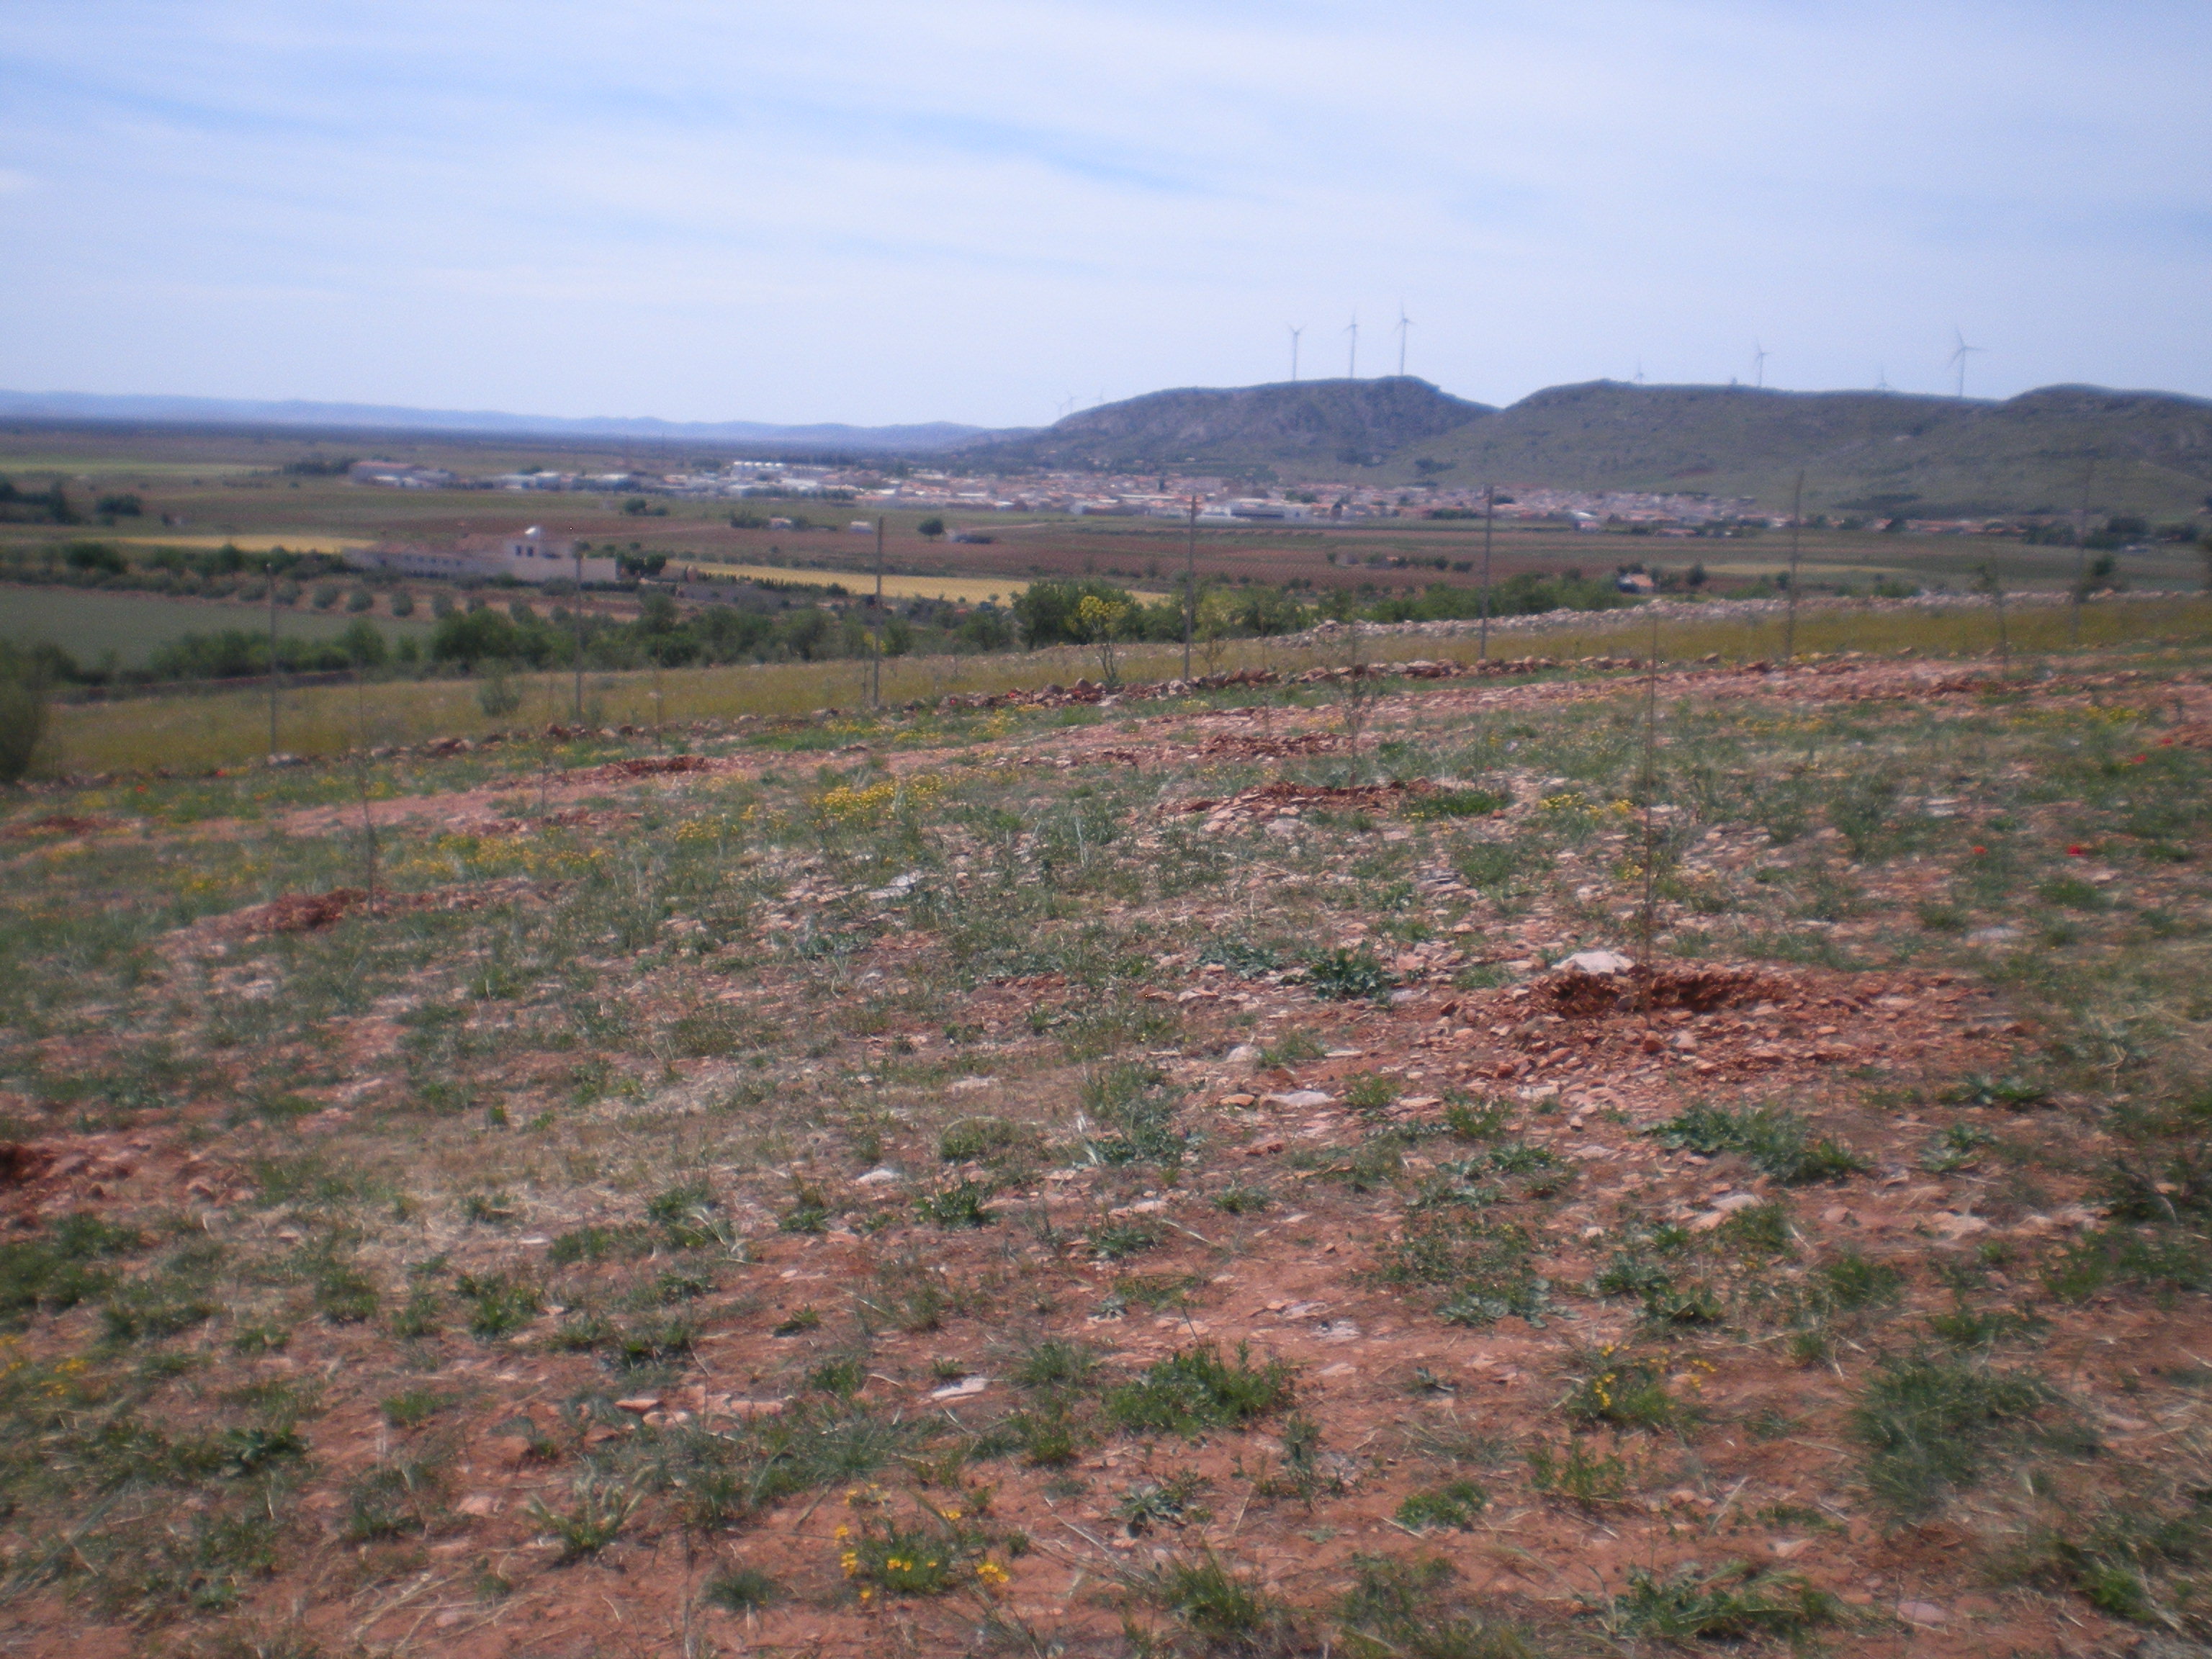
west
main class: Cropland
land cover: Olive groves
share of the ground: < 10 %
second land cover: Spontaneously vegetated surfaces
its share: 10 - 25 %
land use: Agriculture (excluding fallow land and kitchen gardens)
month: May
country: ES
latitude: 38.8279
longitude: -3.5484
